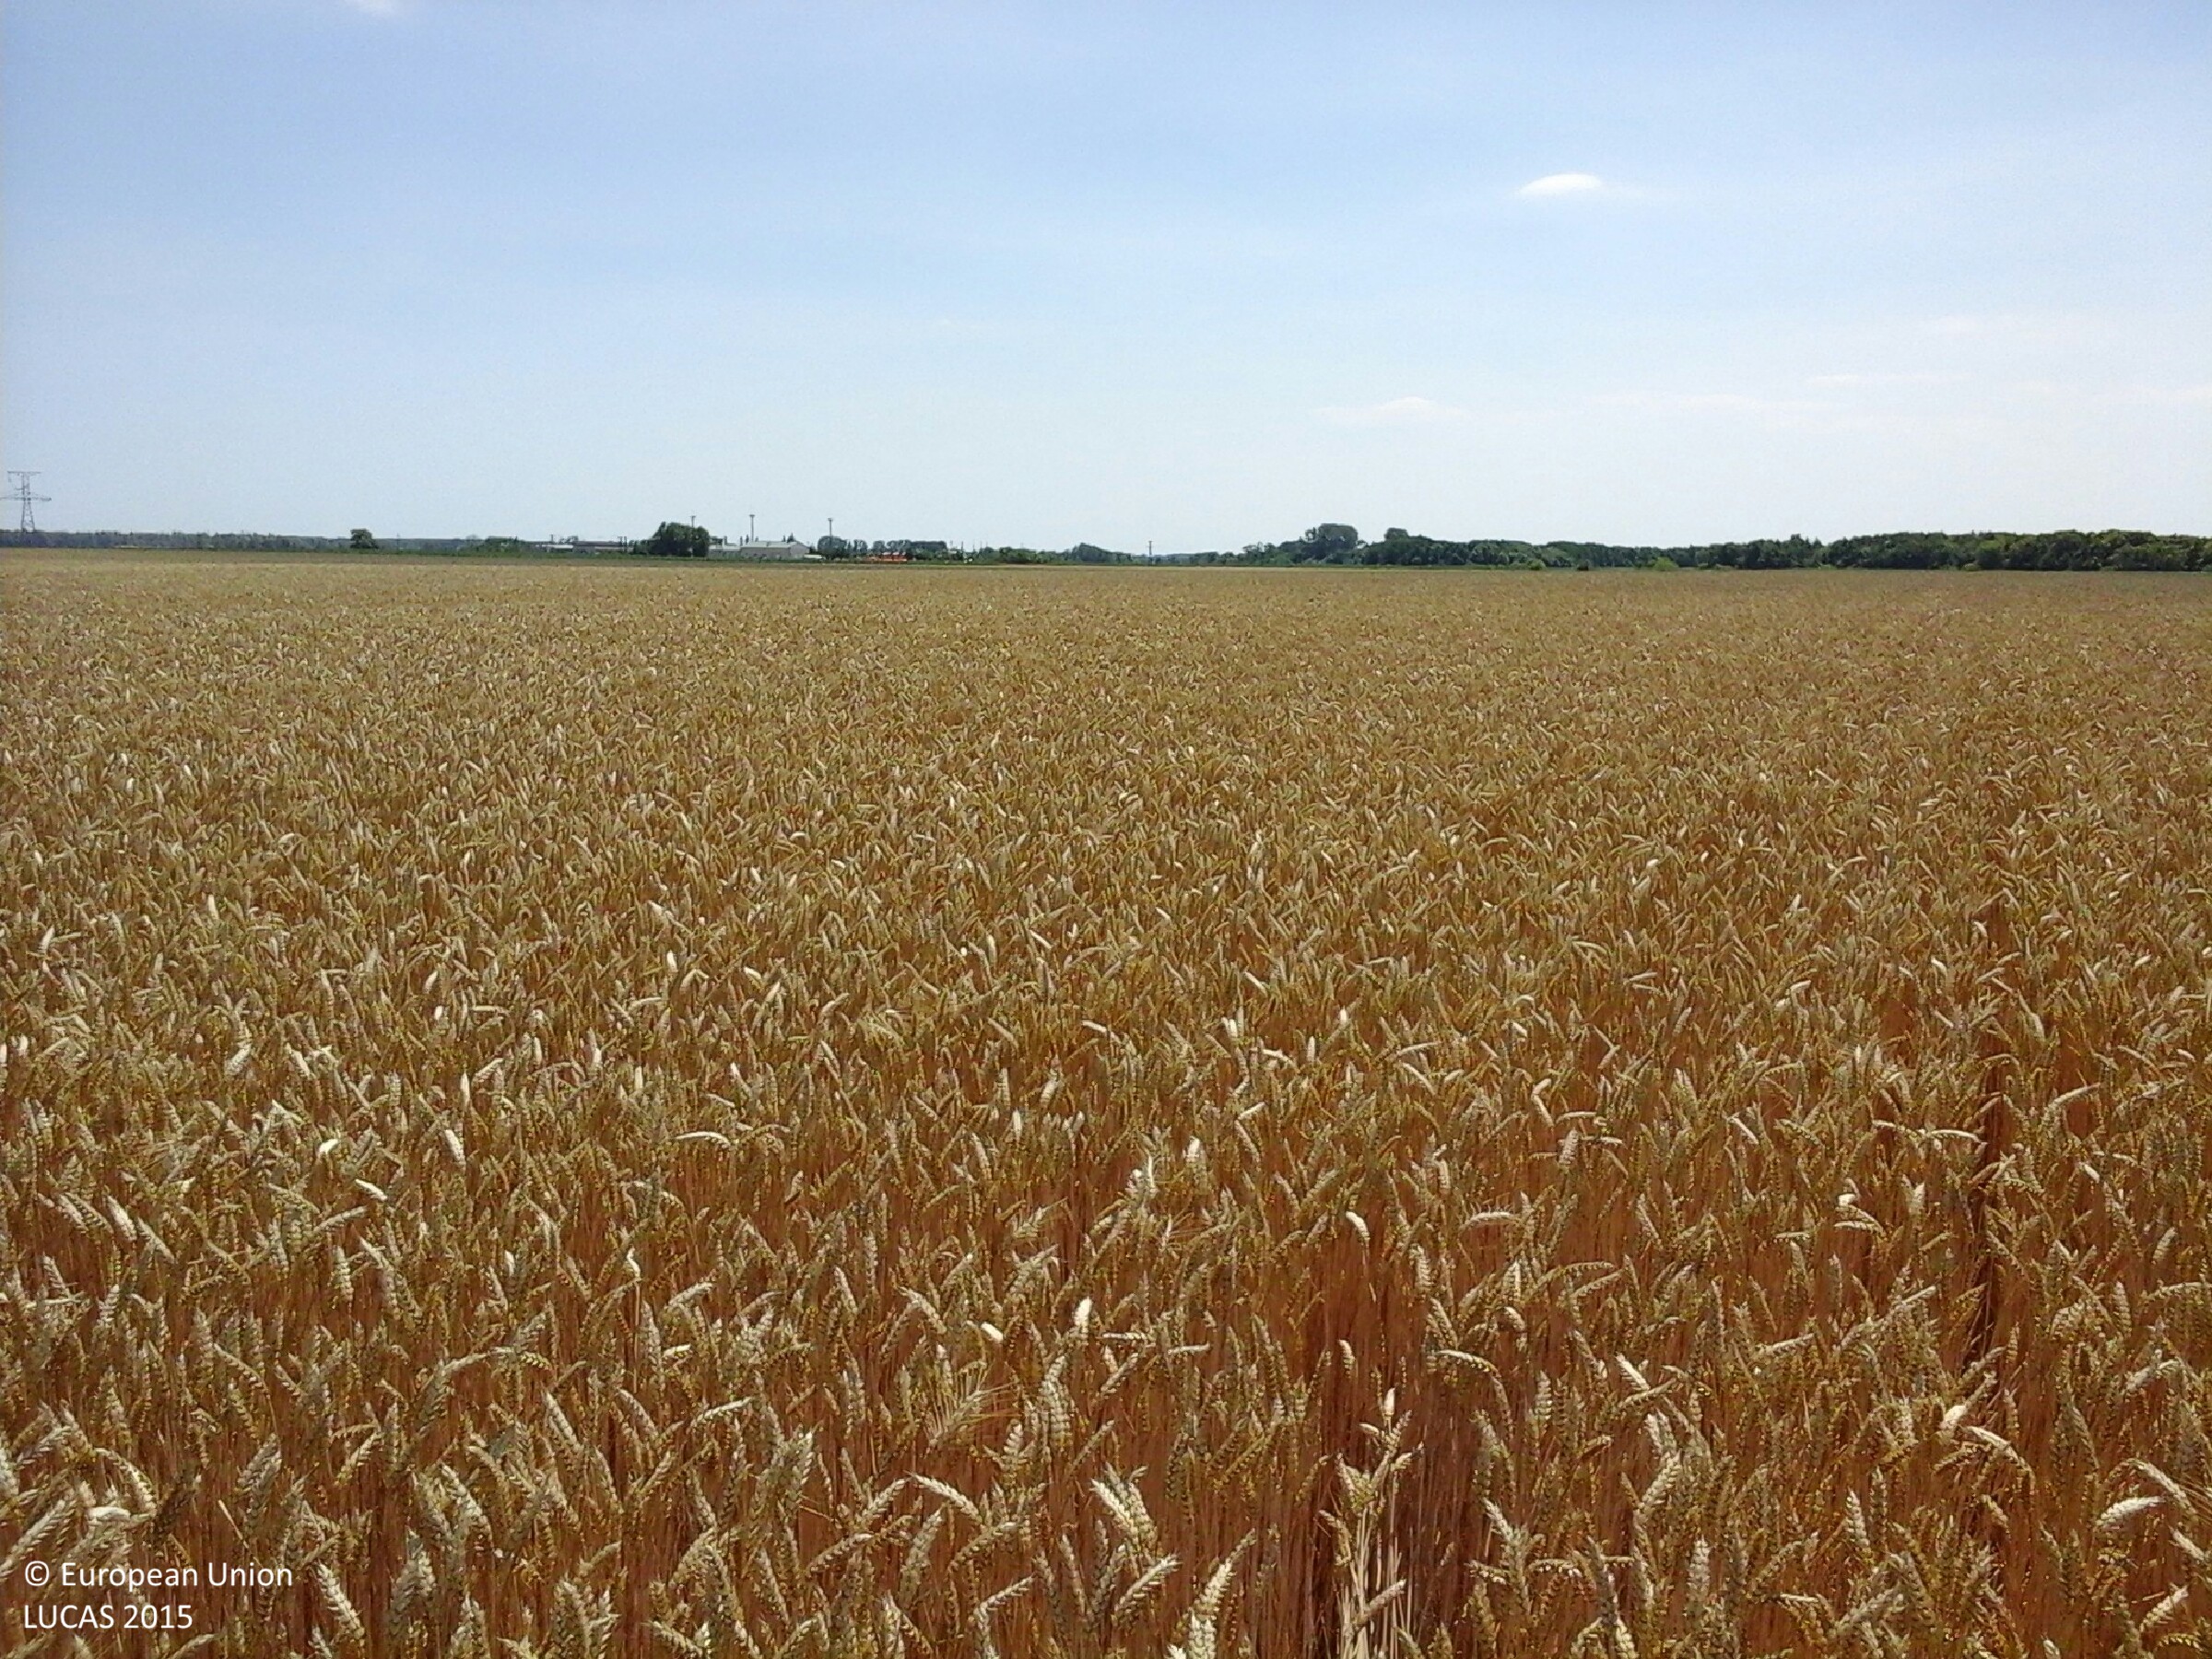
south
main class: Cropland
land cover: Common wheat
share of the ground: > 75 %
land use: Agriculture (excluding fallow land and kitchen gardens)
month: July
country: HU
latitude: 47.8900
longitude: 20.9918
